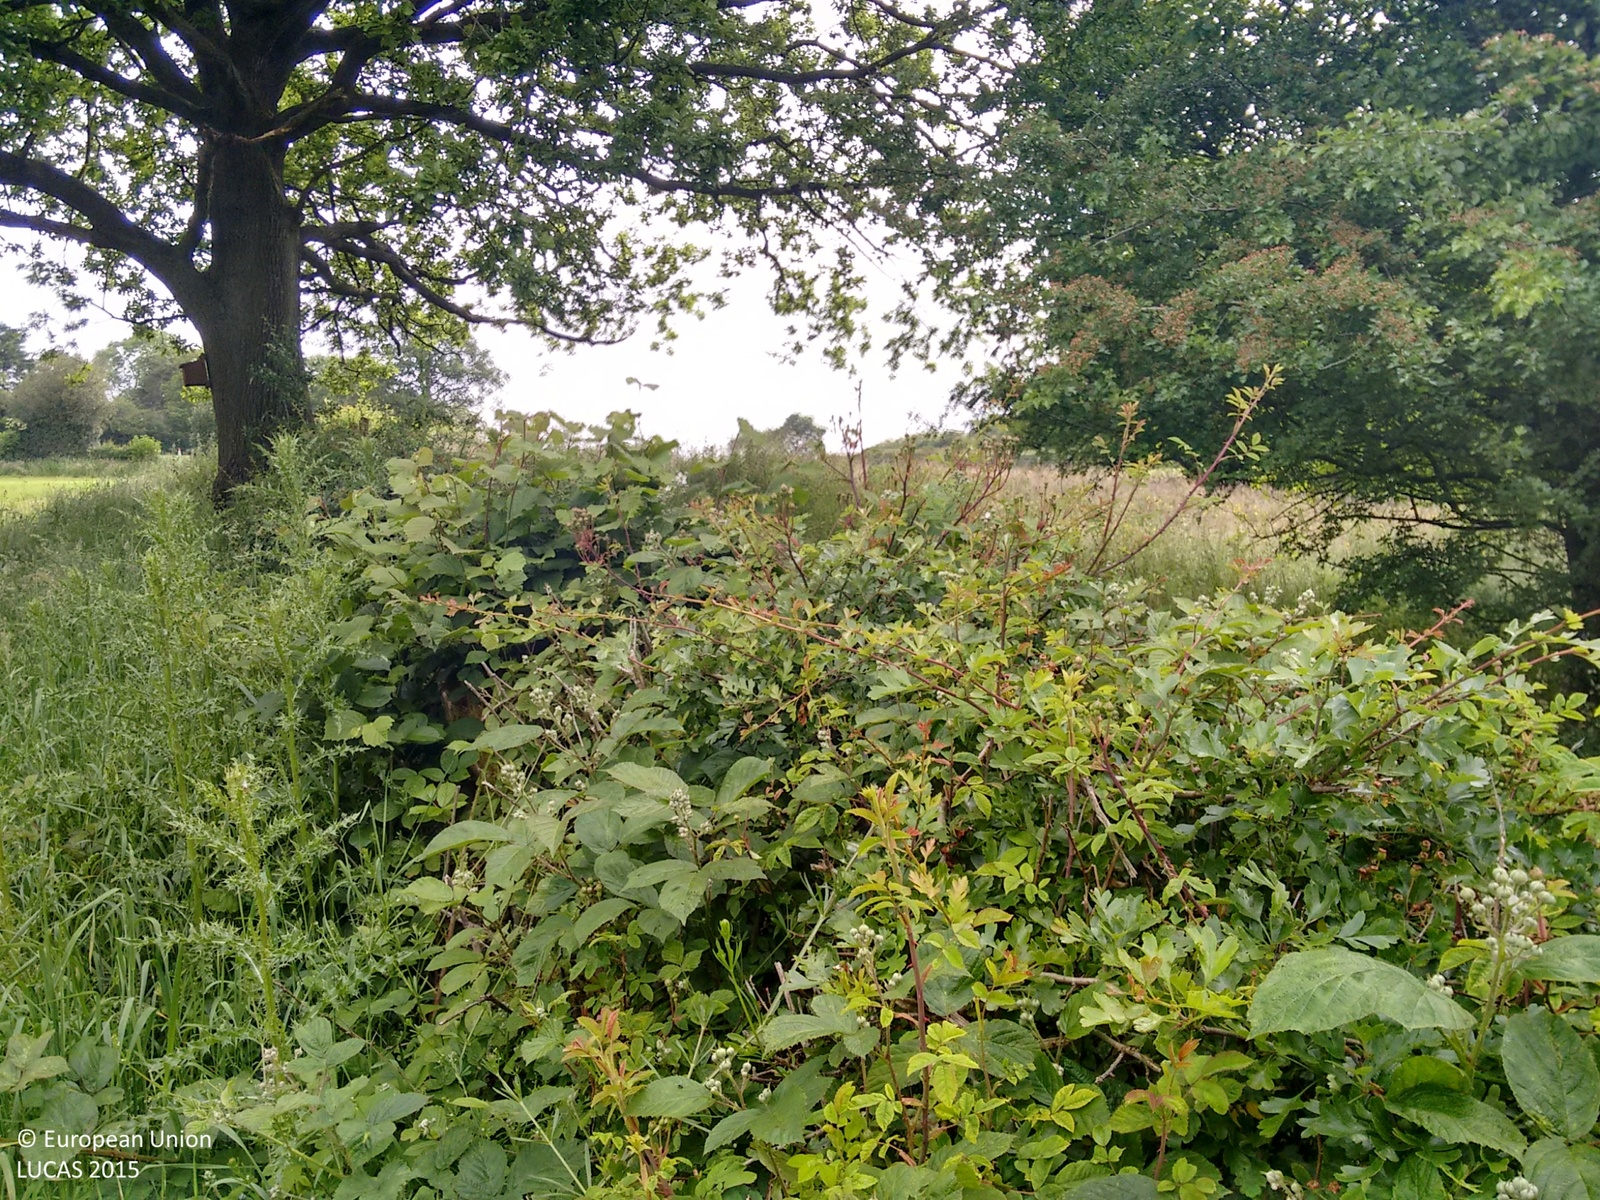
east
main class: Grassland
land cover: Grassland with sparse tree/shrub cover
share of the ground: > 75 %
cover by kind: herbaceous plants 85 %, shrubs 10 %, broadleaved forest trees 5 %
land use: Agriculture (excluding fallow land and kitchen gardens)
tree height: > 5 m
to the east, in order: Grassland with sparse tree/shrub cover; Grassland without tree/shrub cover; Managed hedges; Grass margins; Paved roads, cycling and walking lanes; Grass margins; Managed hedges; Common wheat; Single bushes/trees
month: June
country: GB
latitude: 53.3032
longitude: -1.5303
